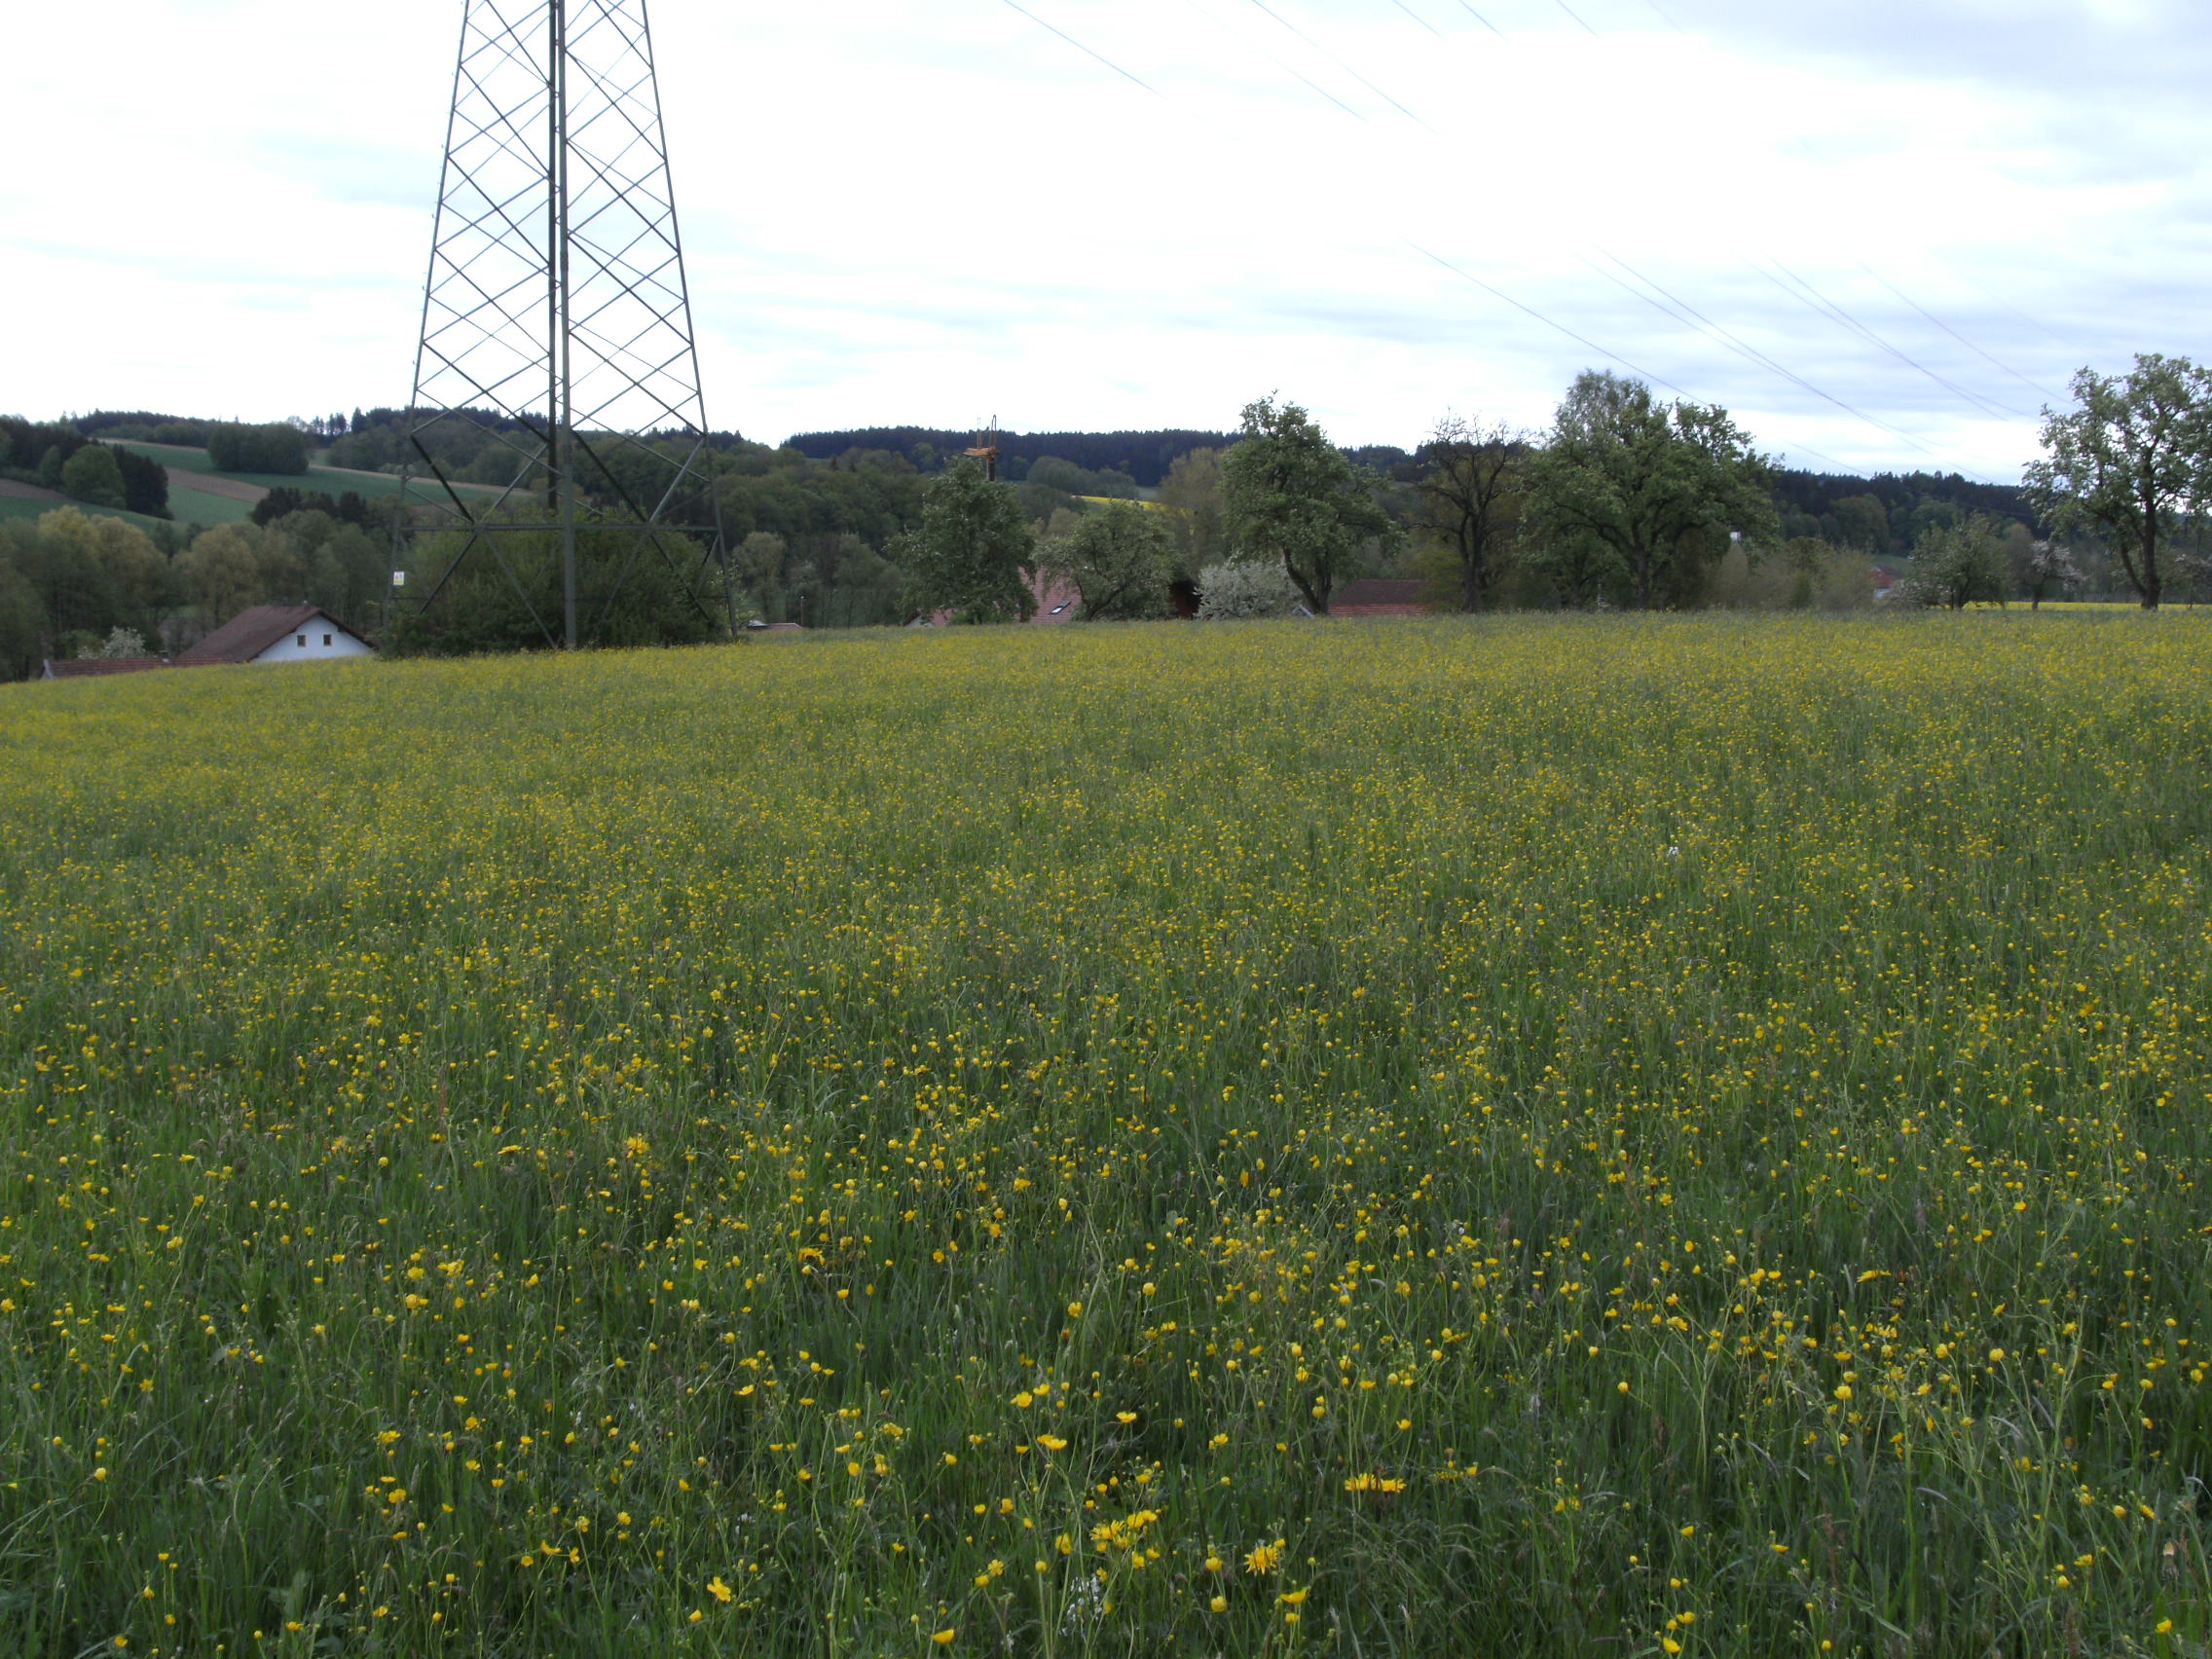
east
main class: Grassland
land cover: Grassland without tree/shrub cover
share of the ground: > 75 %
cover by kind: herbaceous plants 100 %
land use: Agriculture (excluding fallow land and kitchen gardens)
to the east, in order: Grassland without tree/shrub cover; Electric lines; Grassland without tree/shrub cover; Pear fruit; Grassland without tree/shrub cover; Pear fruit; Artificial constructions in urban areas; Grassland without tree/shrub cover
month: May
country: AT
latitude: 48.1899
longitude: 13.3756
